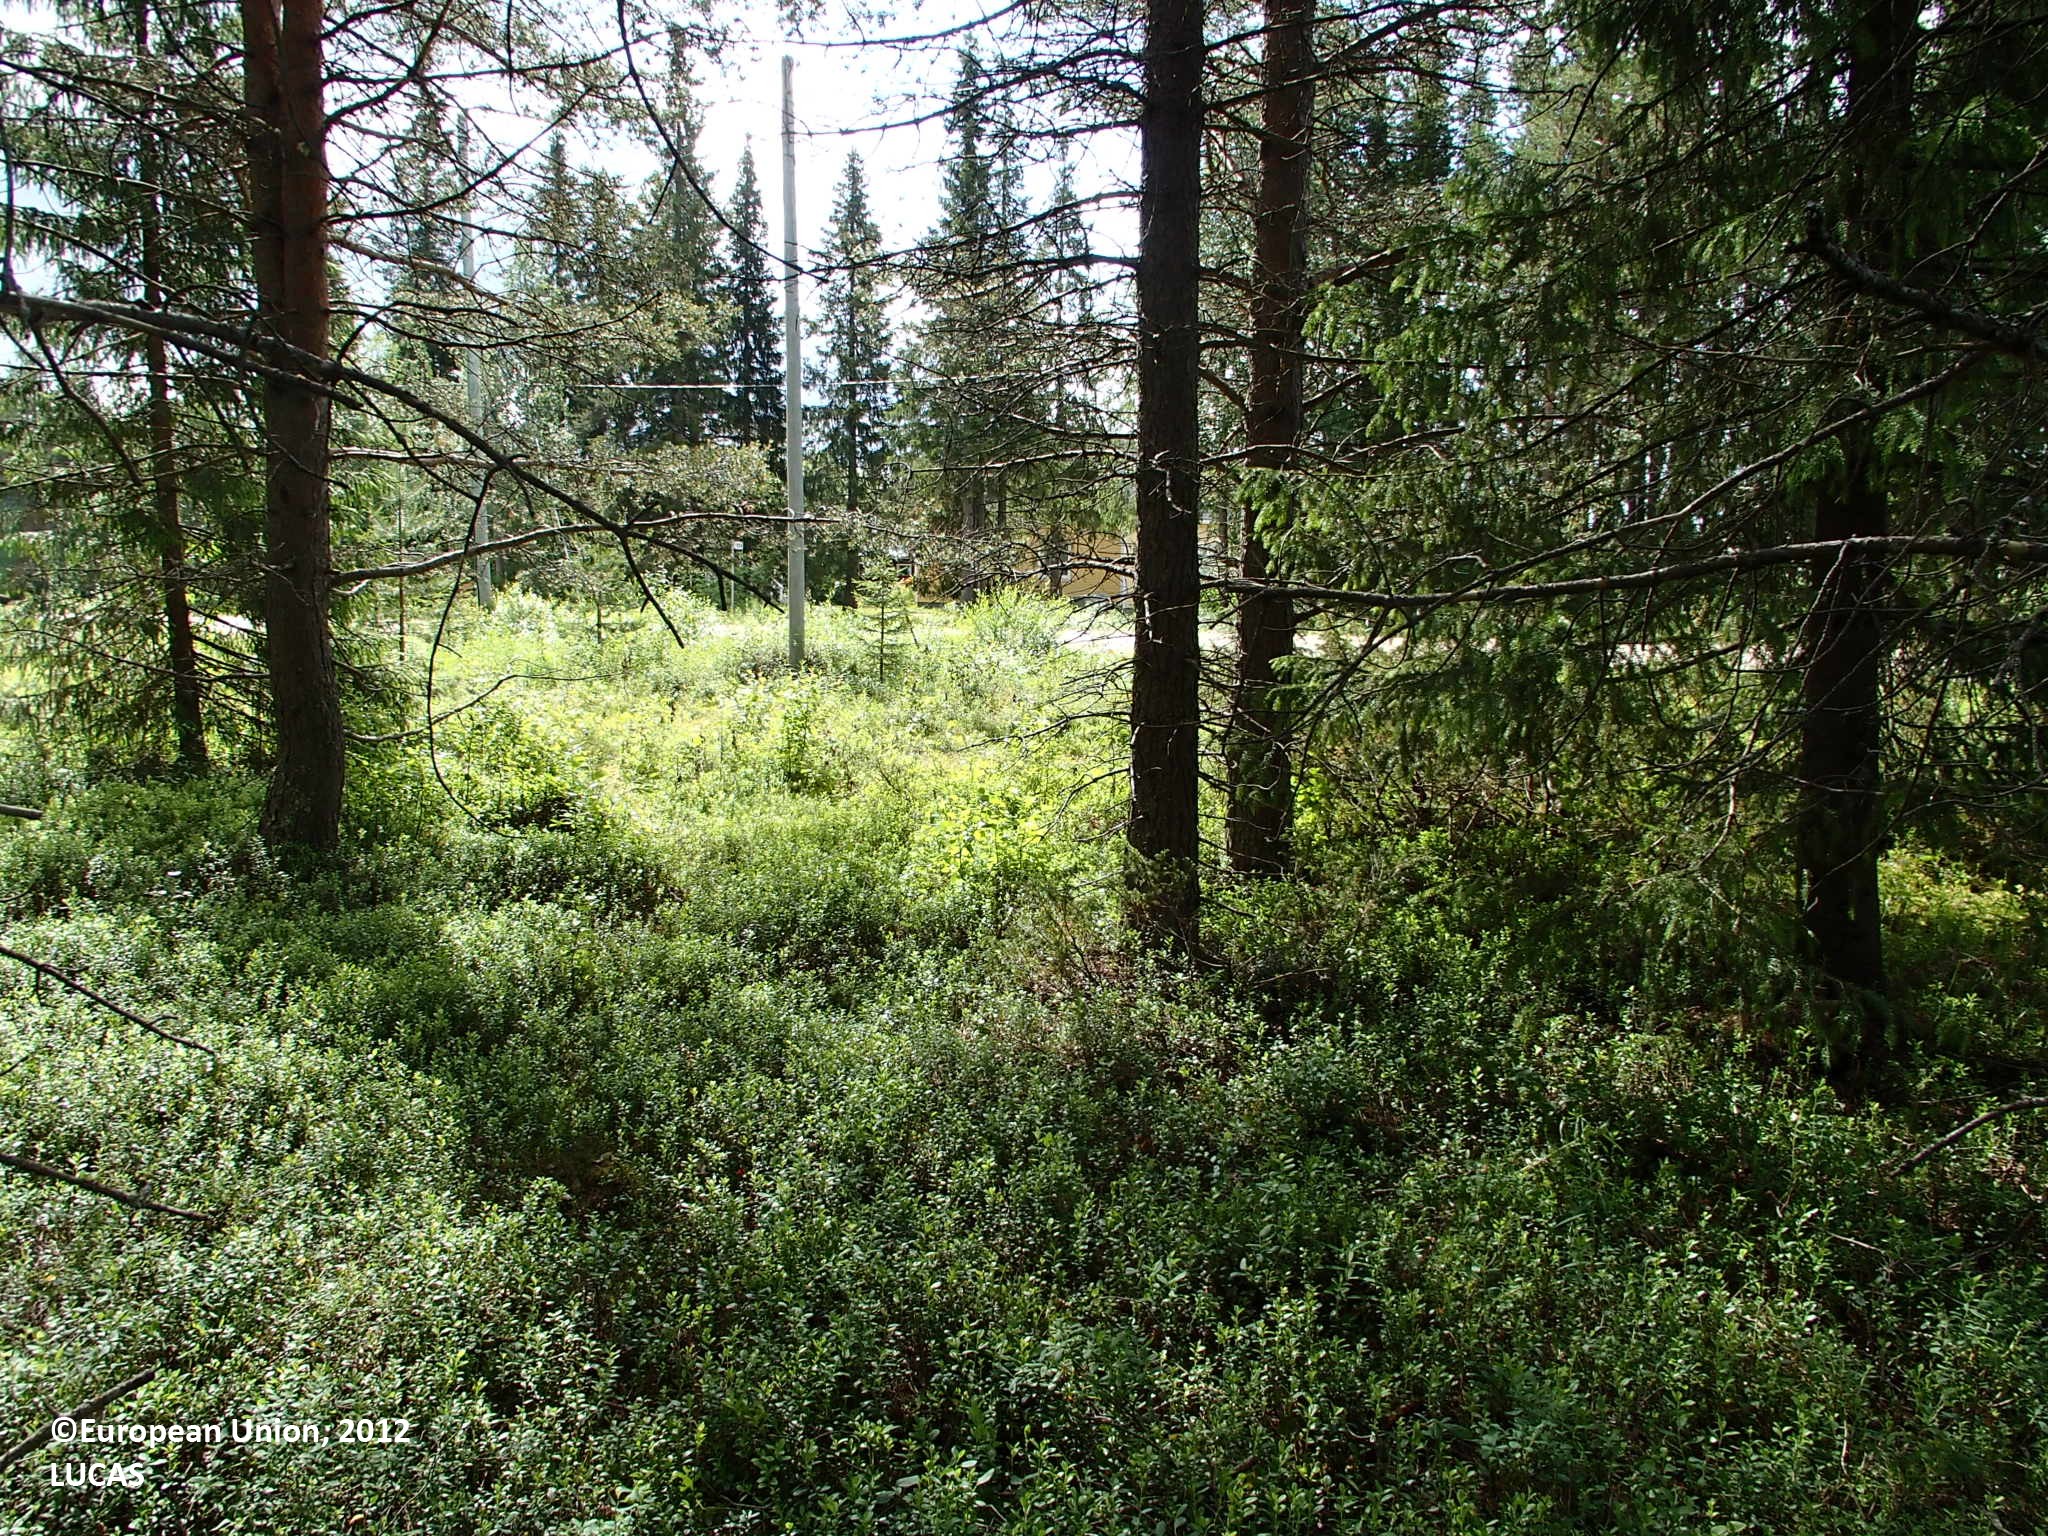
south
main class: Woodland
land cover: Pine dominated coniferous woodland
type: boreal forest
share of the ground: > 75 %
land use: Forestry
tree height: > 5 m
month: July
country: FI
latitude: 67.2762
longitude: 25.5262
